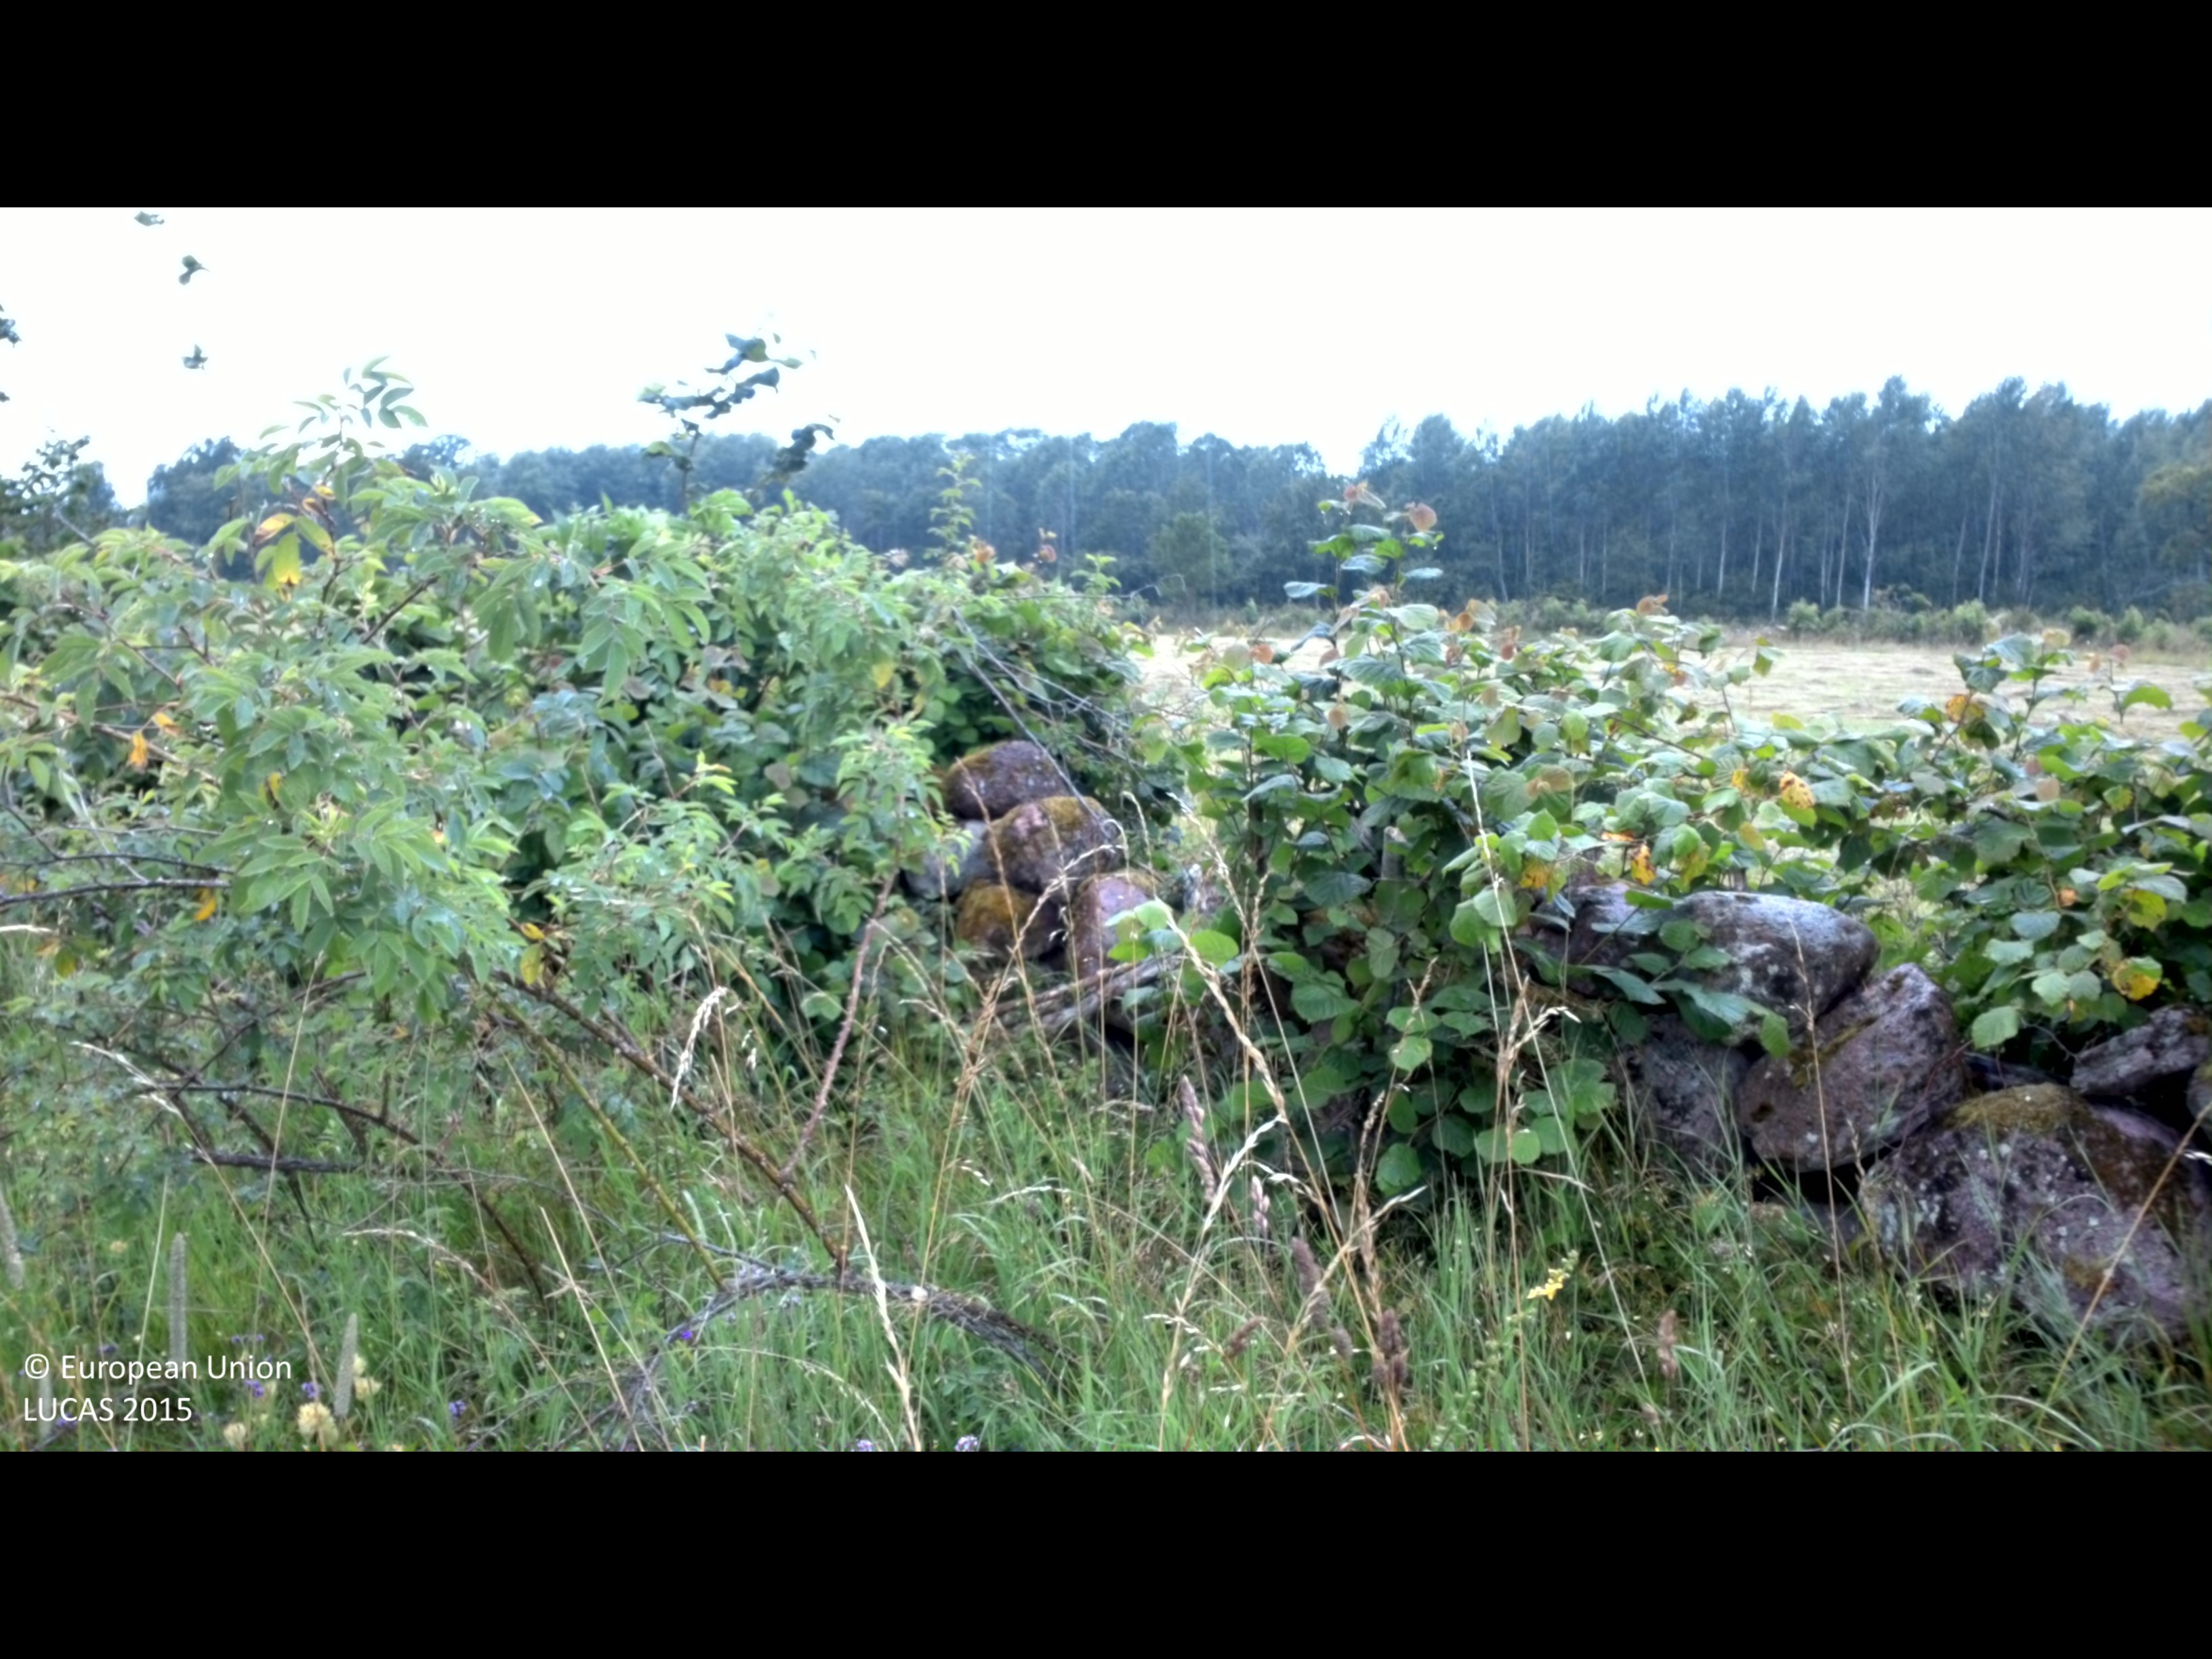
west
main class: Shrubland
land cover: Shrubland with sparse tree cover
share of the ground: > 75 %
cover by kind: shrubs 85 %, herbaceous plants 10 %, broadleaved forest trees 5 %
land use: Fallow land
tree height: > 5 m
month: July
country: SE
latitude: 56.7190
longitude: 16.6520
